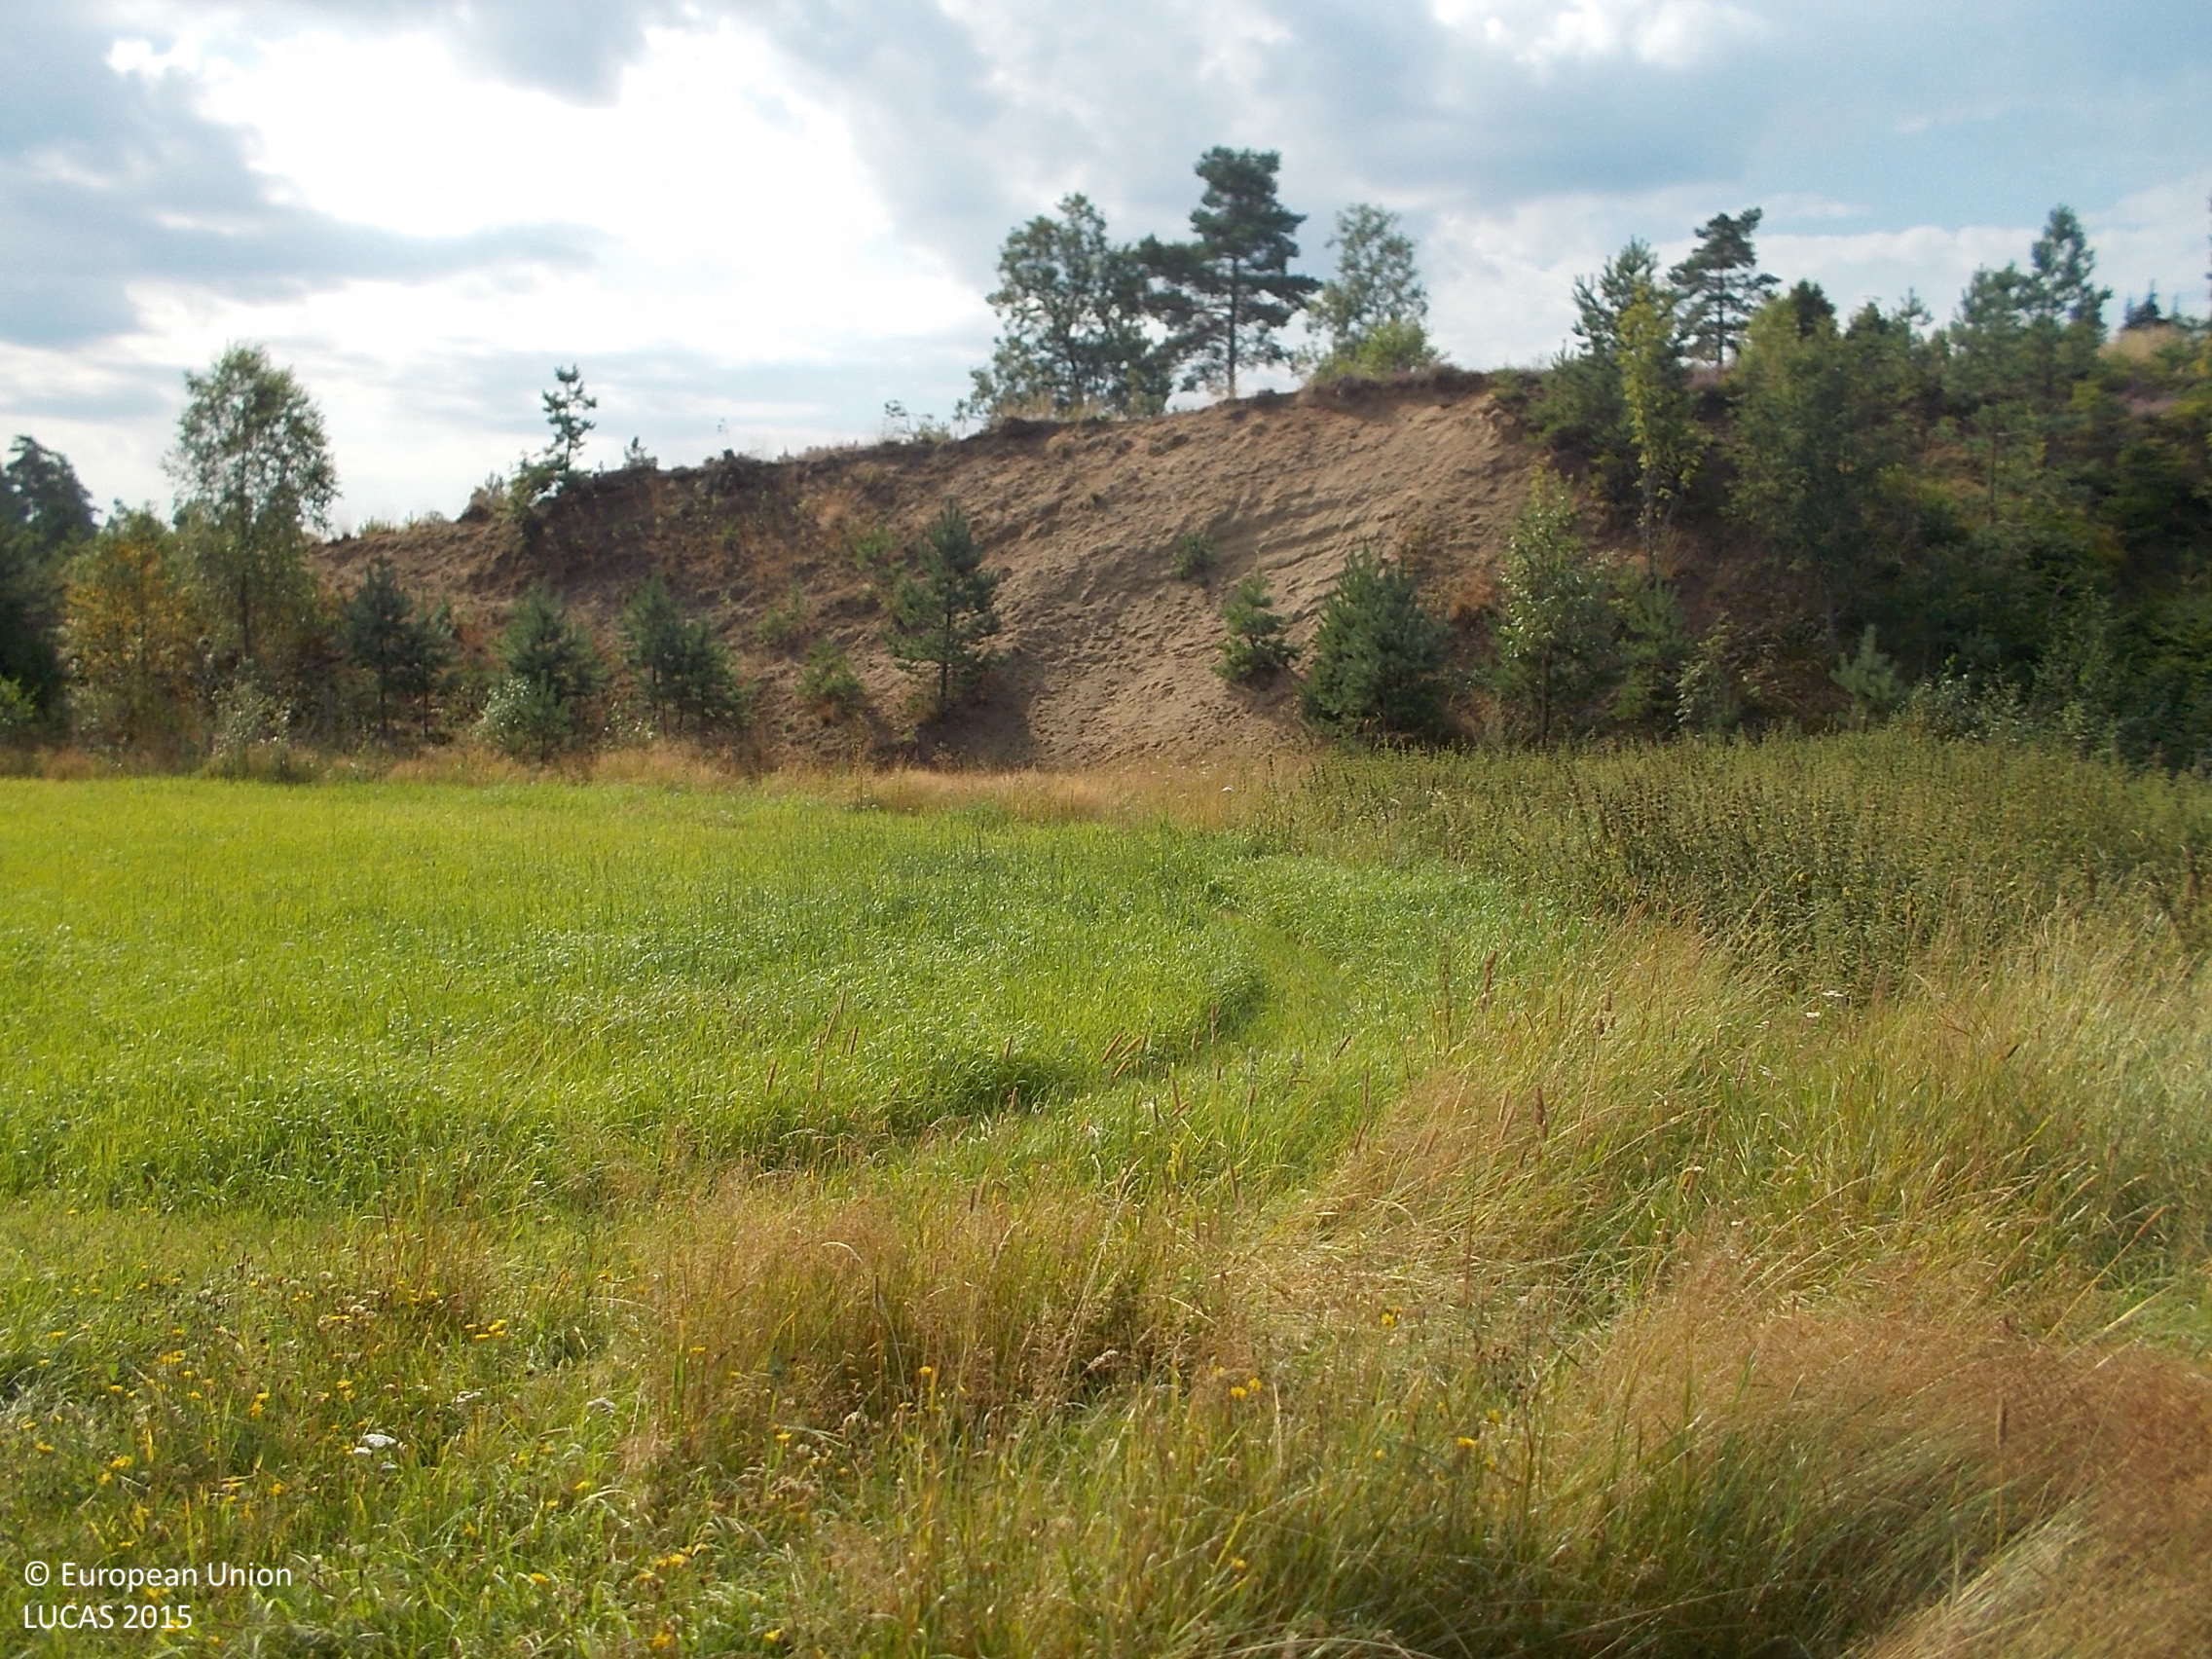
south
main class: Grassland
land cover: Grassland without tree/shrub cover
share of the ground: > 75 %
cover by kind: herbaceous plants 100 %
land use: Agriculture (excluding fallow land and kitchen gardens)
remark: Harvested field
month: August
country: SE
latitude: 57.3925
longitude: 13.0740
